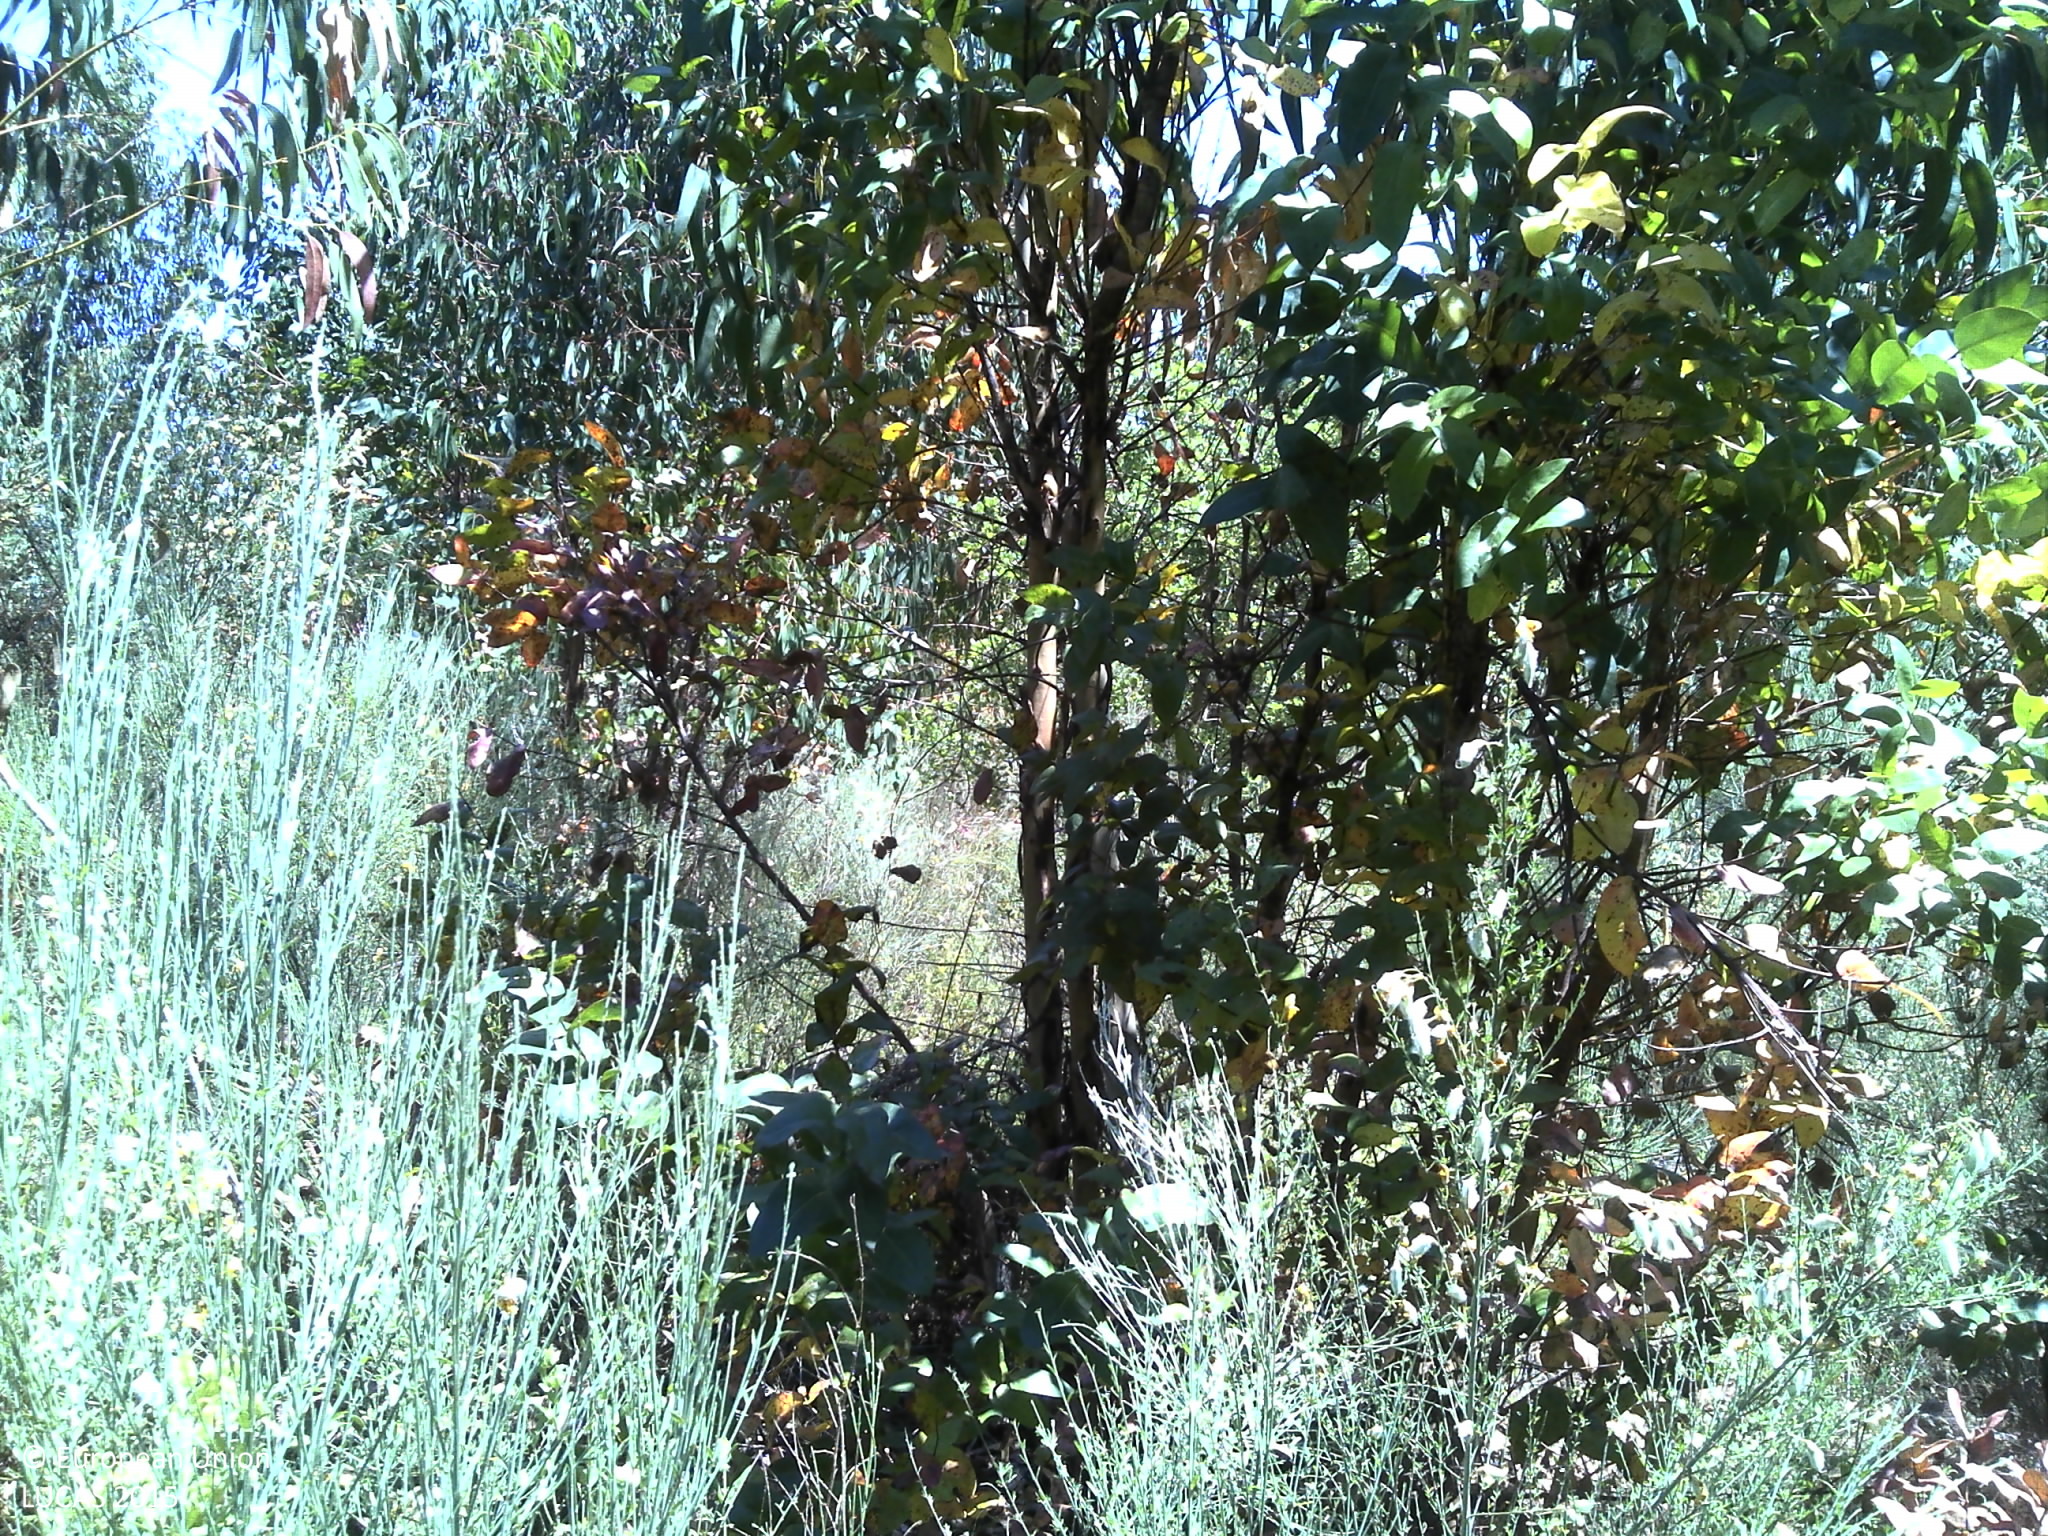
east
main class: Woodland
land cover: Broadleaved woodland
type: exotic forest
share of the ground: 50 - 75 %
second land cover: Shrubland without tree cover
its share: > 75 %
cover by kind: broadleaved forest trees 75 %, shrubs 25 %
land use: Forestry
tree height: > 5 m
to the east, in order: Broadleaved woodland; Shrubland without tree cover; Broadleaved woodland
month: May
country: PT
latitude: 39.4688
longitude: -7.7316
